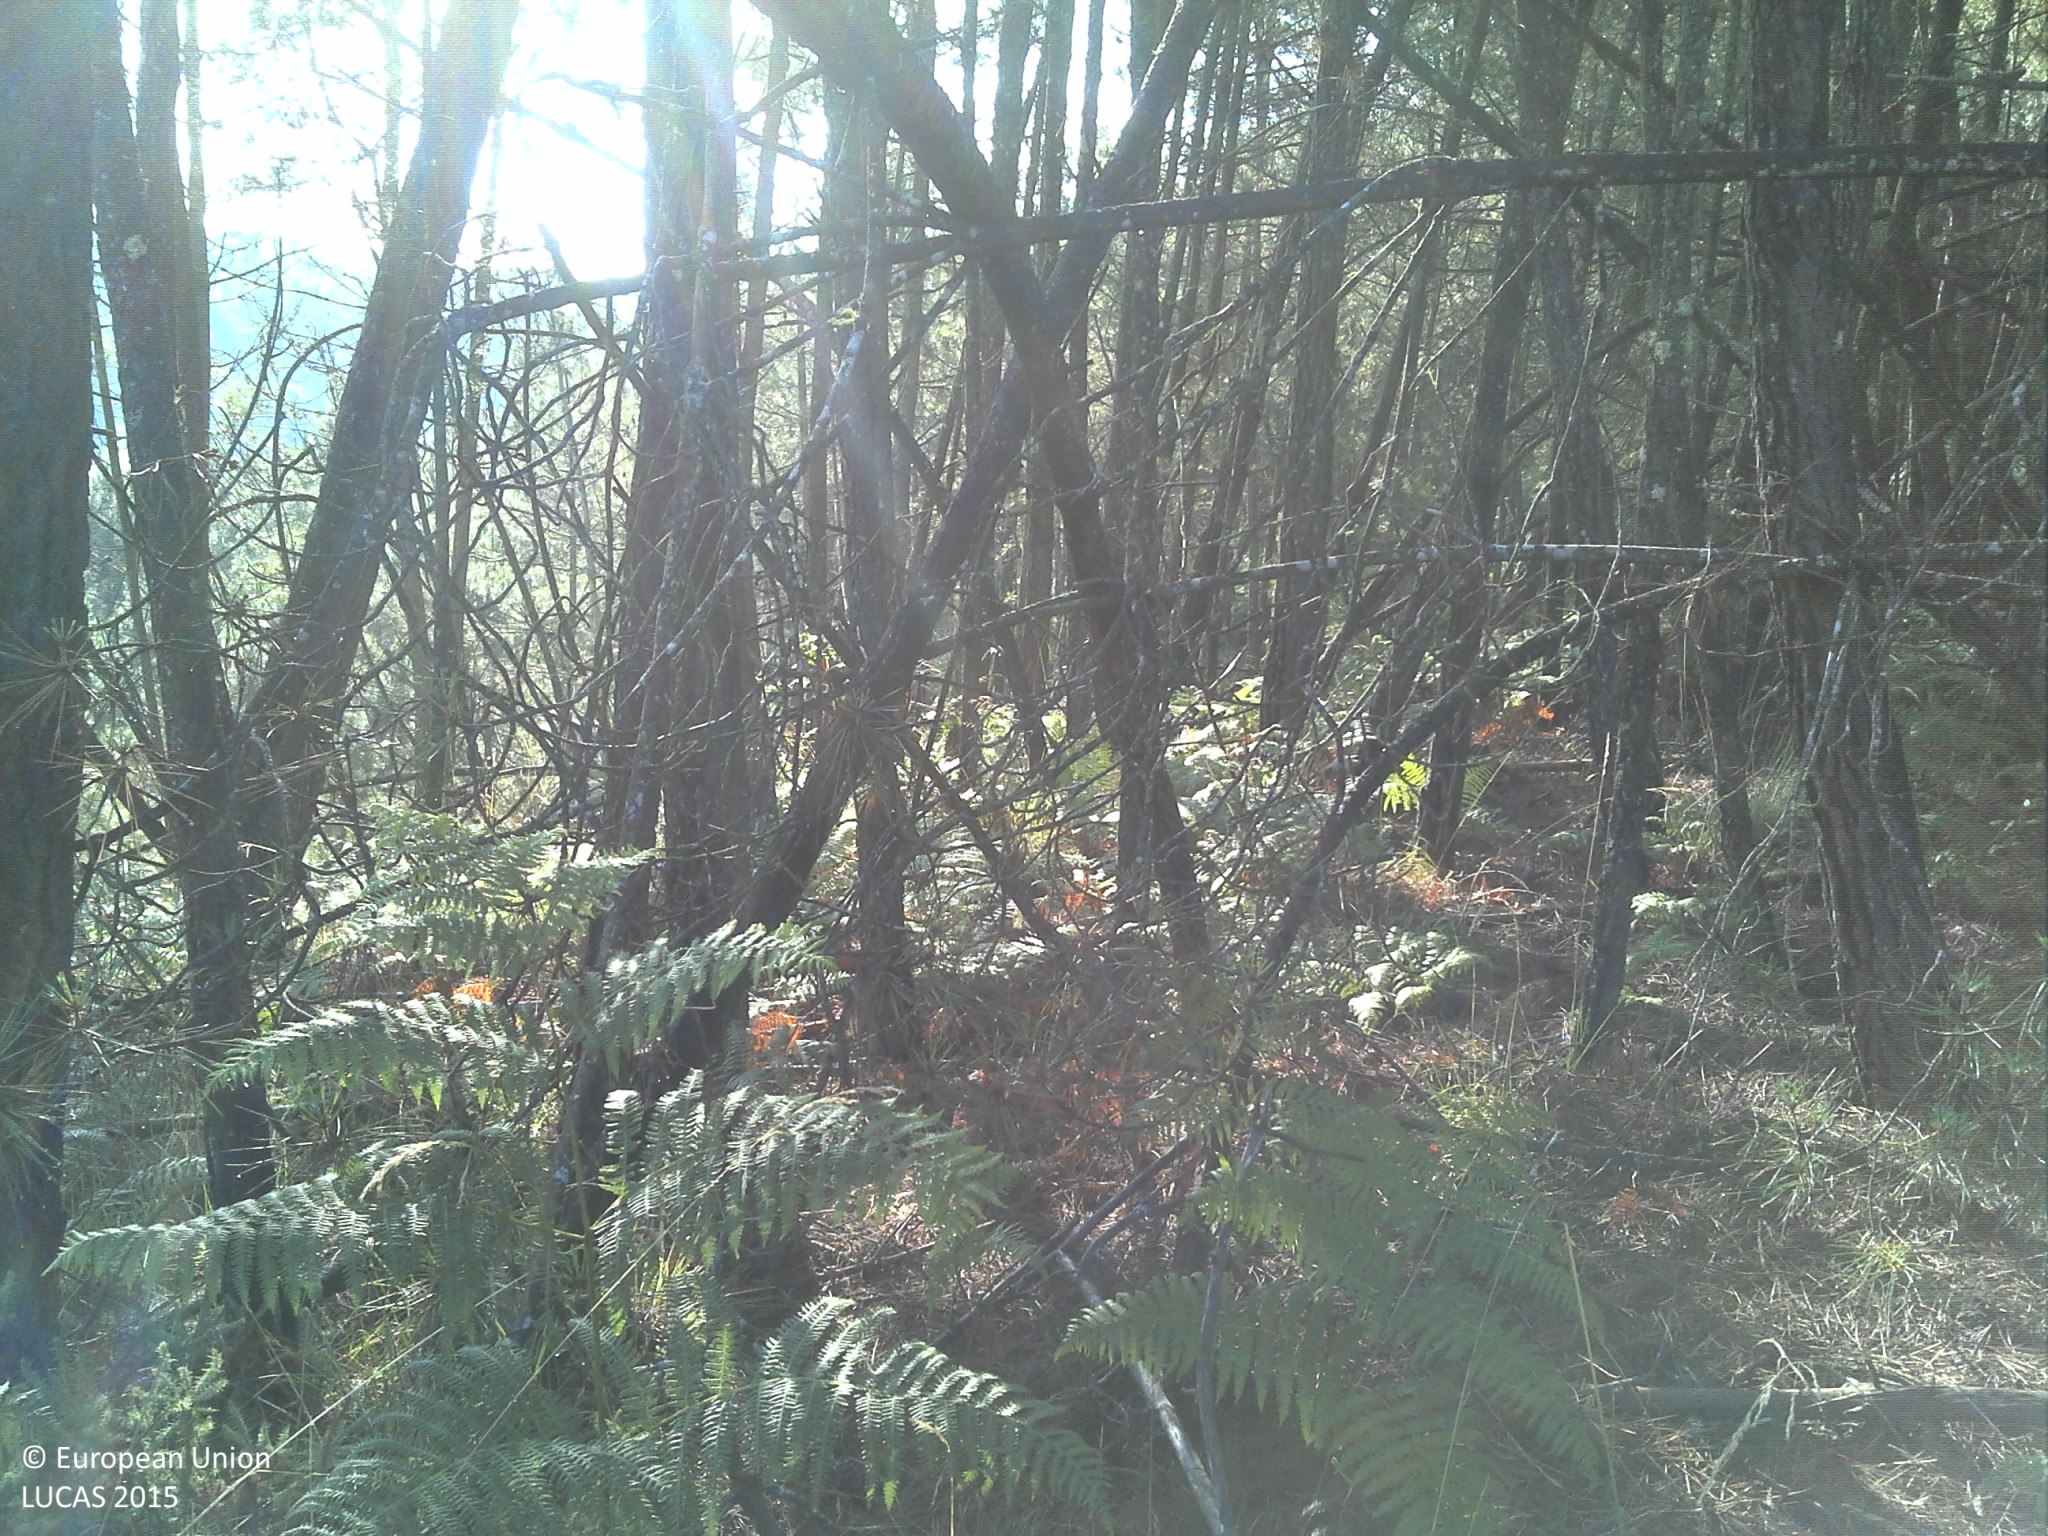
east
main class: Woodland
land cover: Pine dominated coniferous woodland
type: coniferous forest of the mediterranean region
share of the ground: 10 - 25 %
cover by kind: unconsolidated bare surface 45 %, shrubs 35 %, coniferous forest trees 20 %
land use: Forestry
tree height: > 5 m
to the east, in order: Pine dominated coniferous woodland; Shrubland without tree cover; Pine dominated coniferous woodland; Shrubland with sparse tree cover
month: June
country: PT
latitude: 41.2405
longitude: -7.6308
